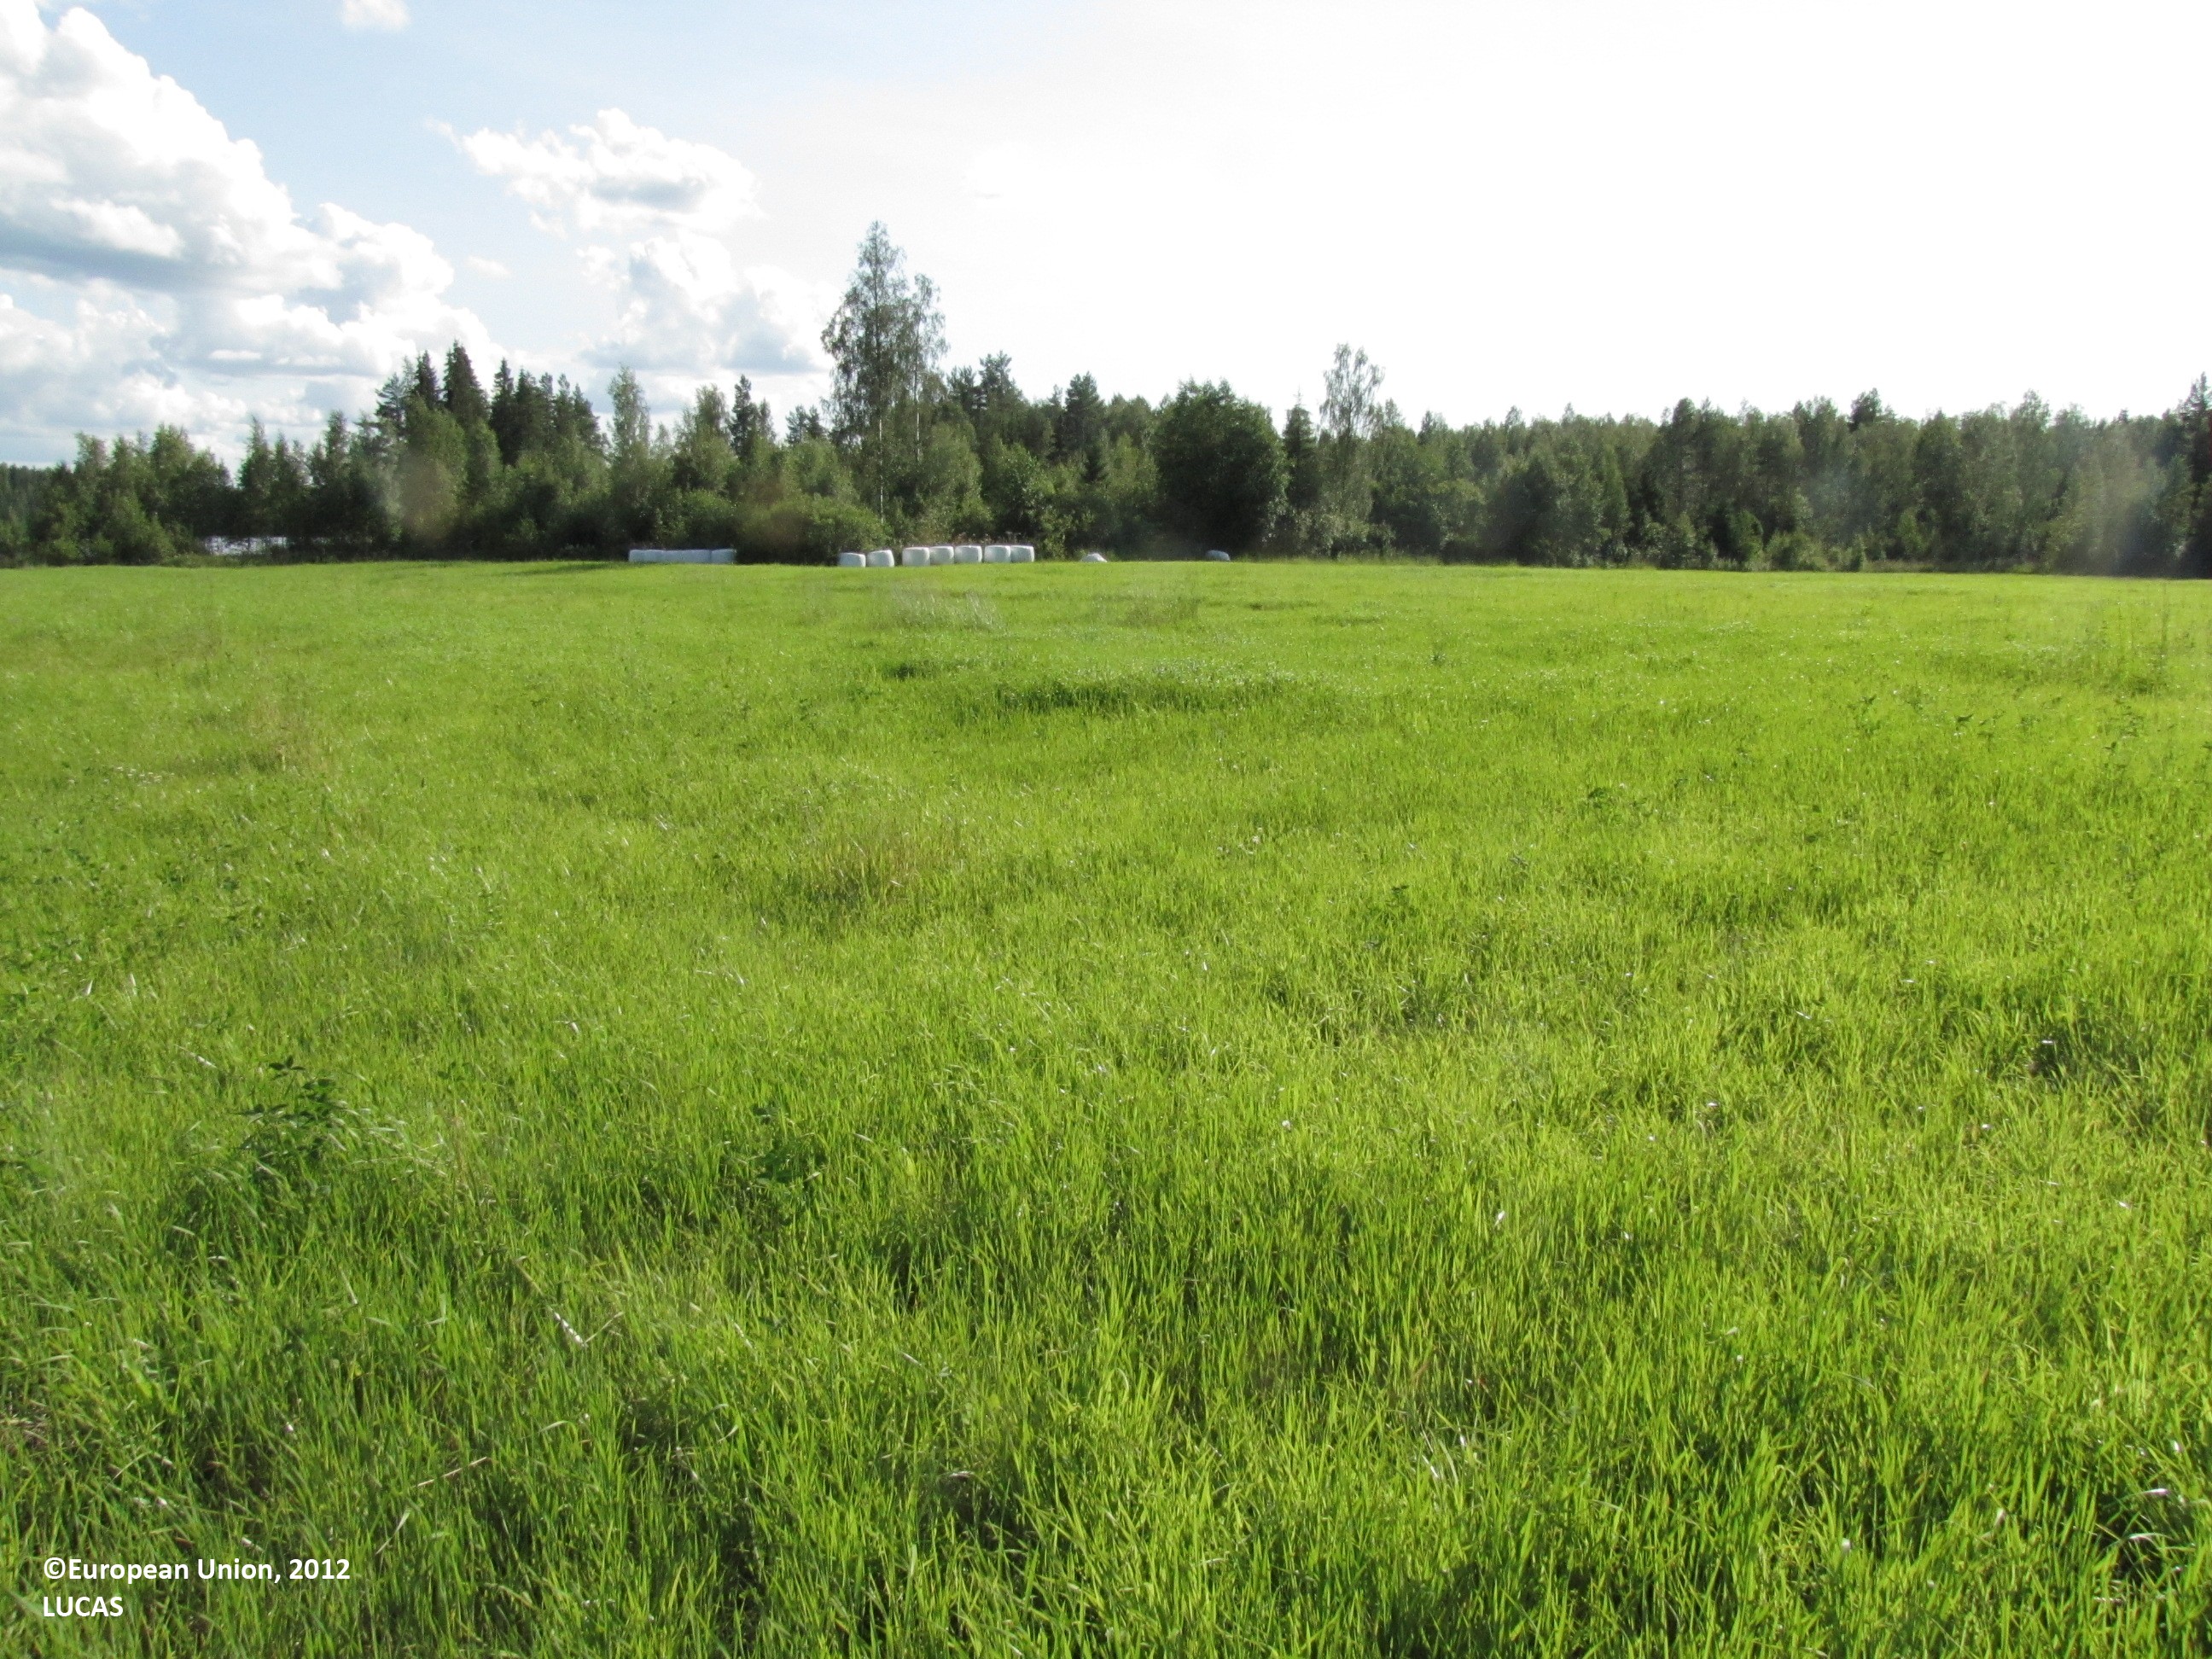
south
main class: Cropland
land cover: Temporary grasslands
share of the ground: > 75 %
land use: Agriculture (excluding fallow land and kitchen gardens)
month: July
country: FI
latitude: 62.1296
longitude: 23.0875
